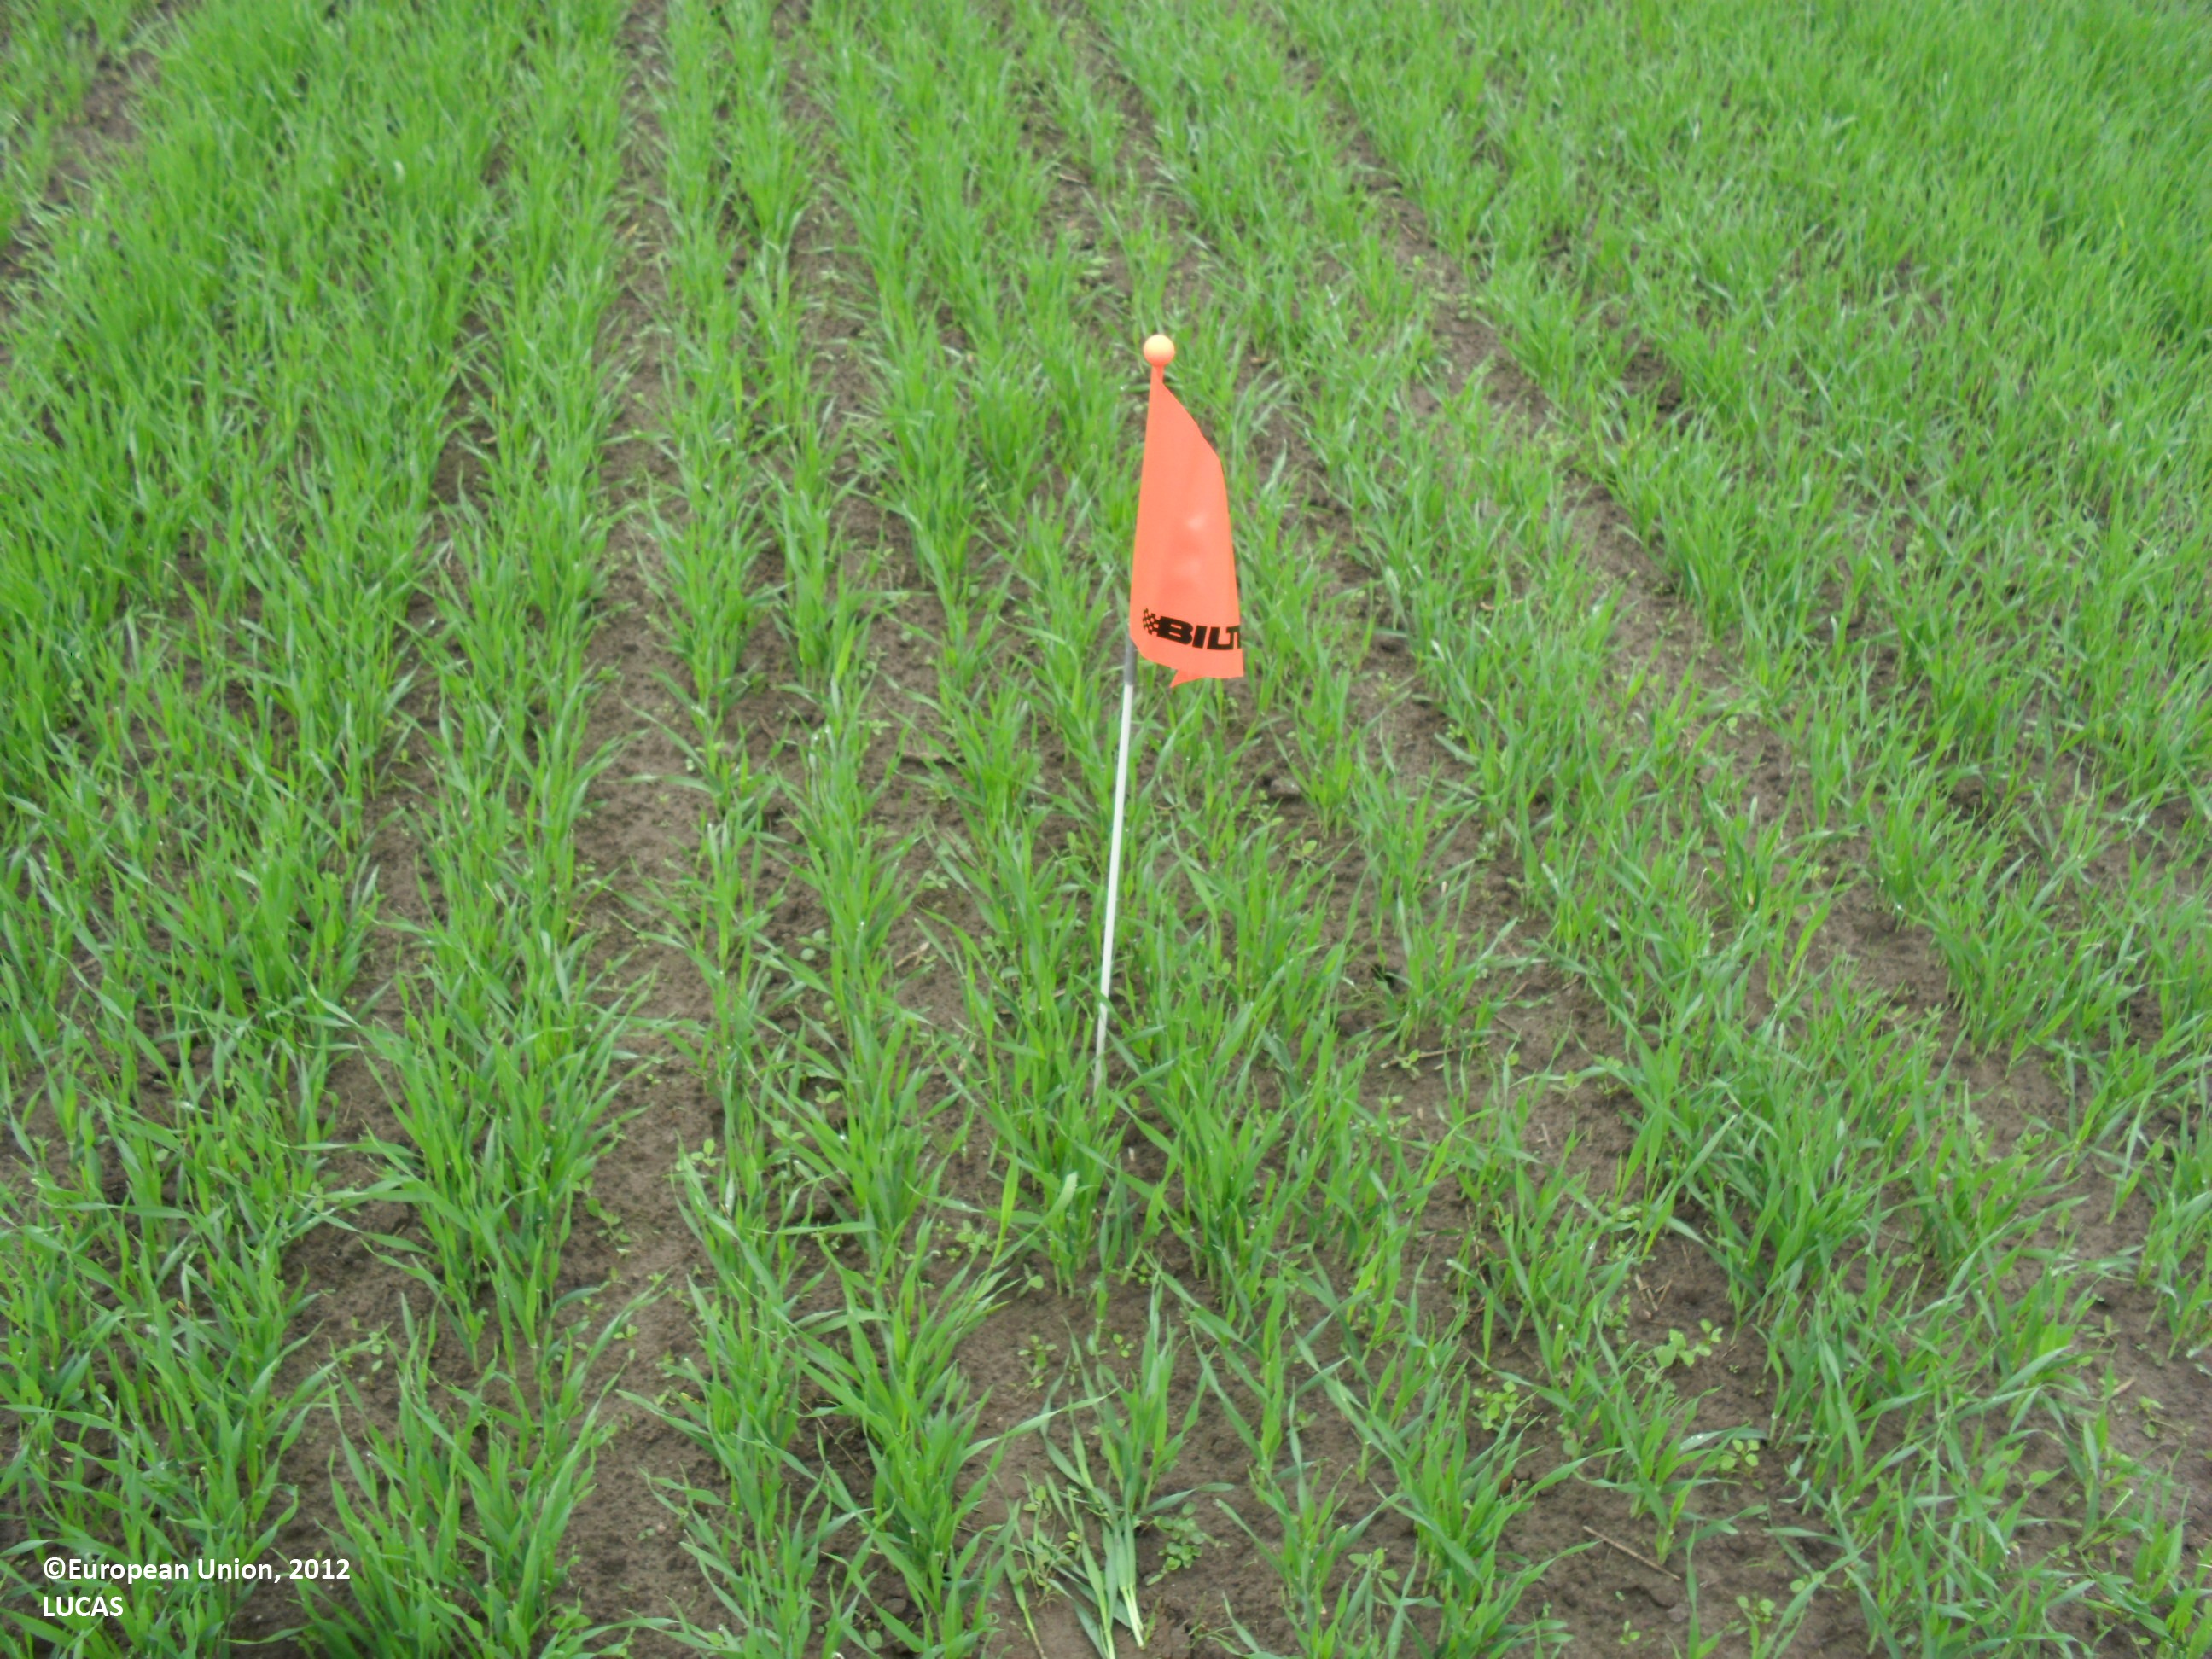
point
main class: Cropland
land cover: Barley
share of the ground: 50 - 75 %
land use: Agriculture (excluding fallow land and kitchen gardens)
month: June
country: FI
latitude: 63.0745
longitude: 23.1843
